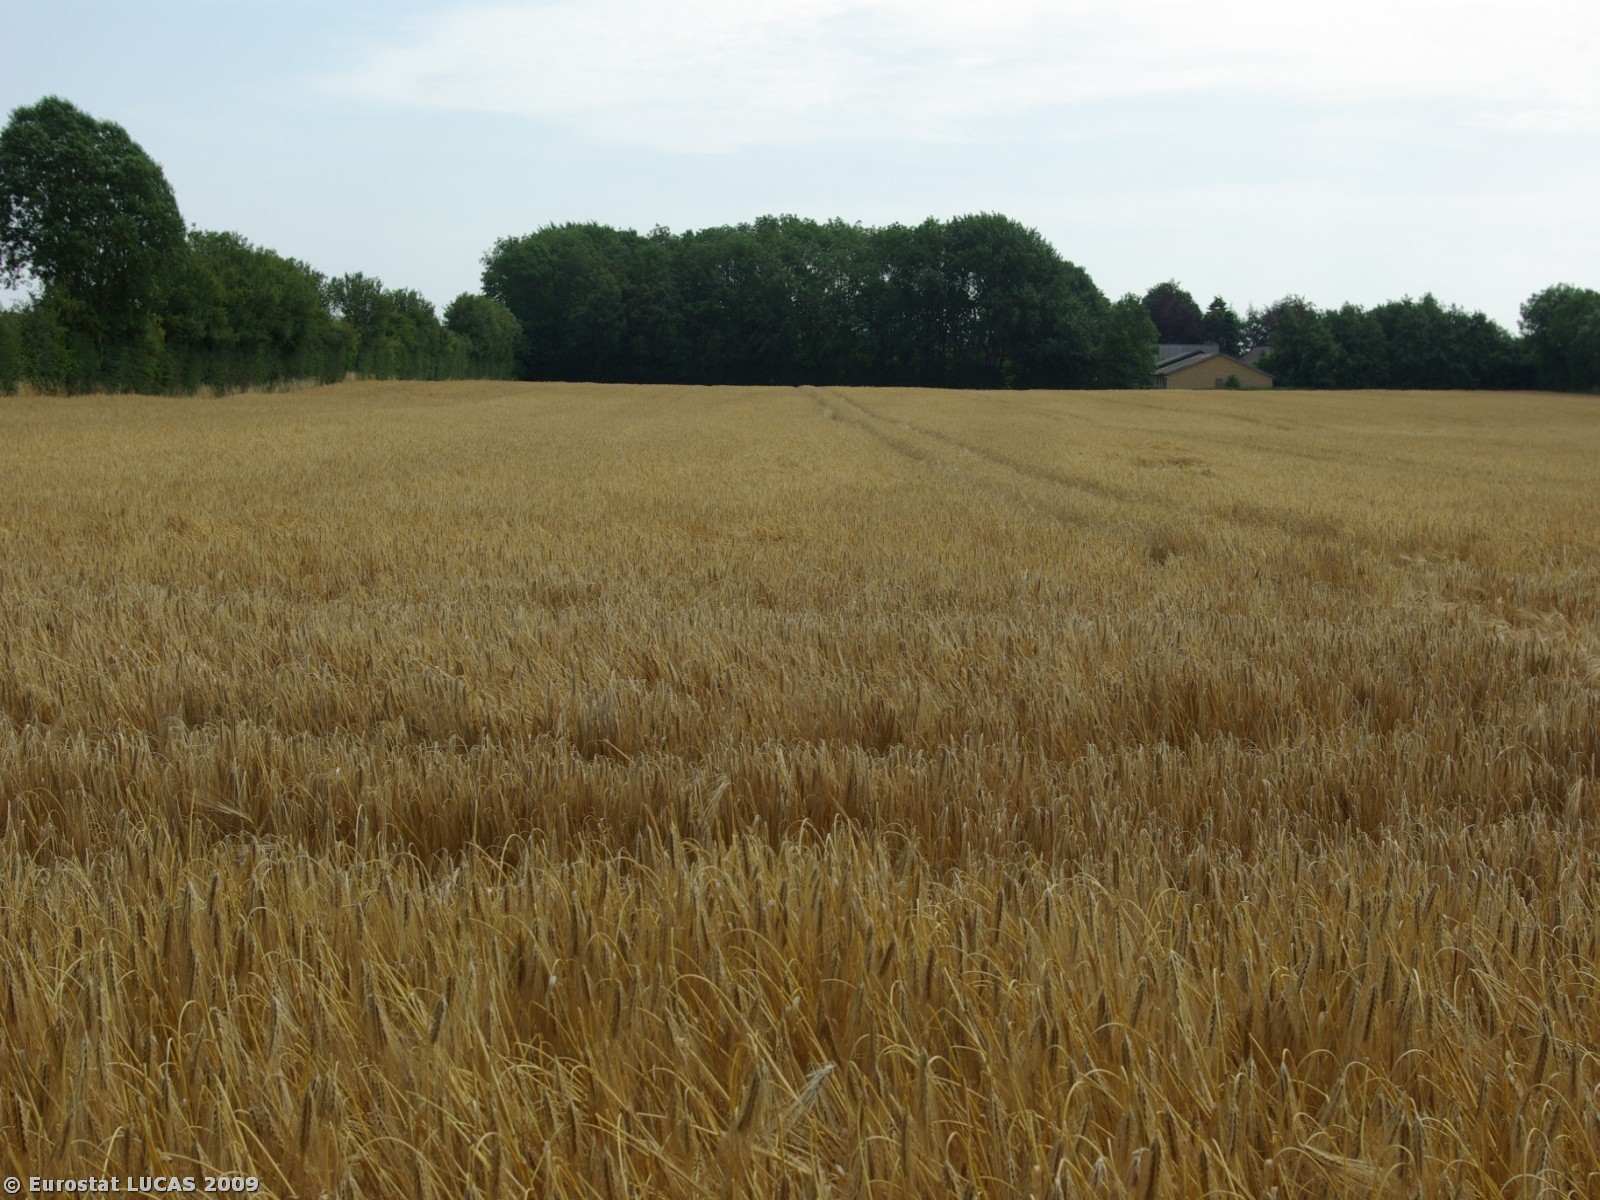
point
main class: Cropland
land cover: Barley
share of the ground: > 75 %
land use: Agriculture (excluding fallow land and kitchen gardens)
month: July
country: DK
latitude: 54.8936
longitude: 10.0467
